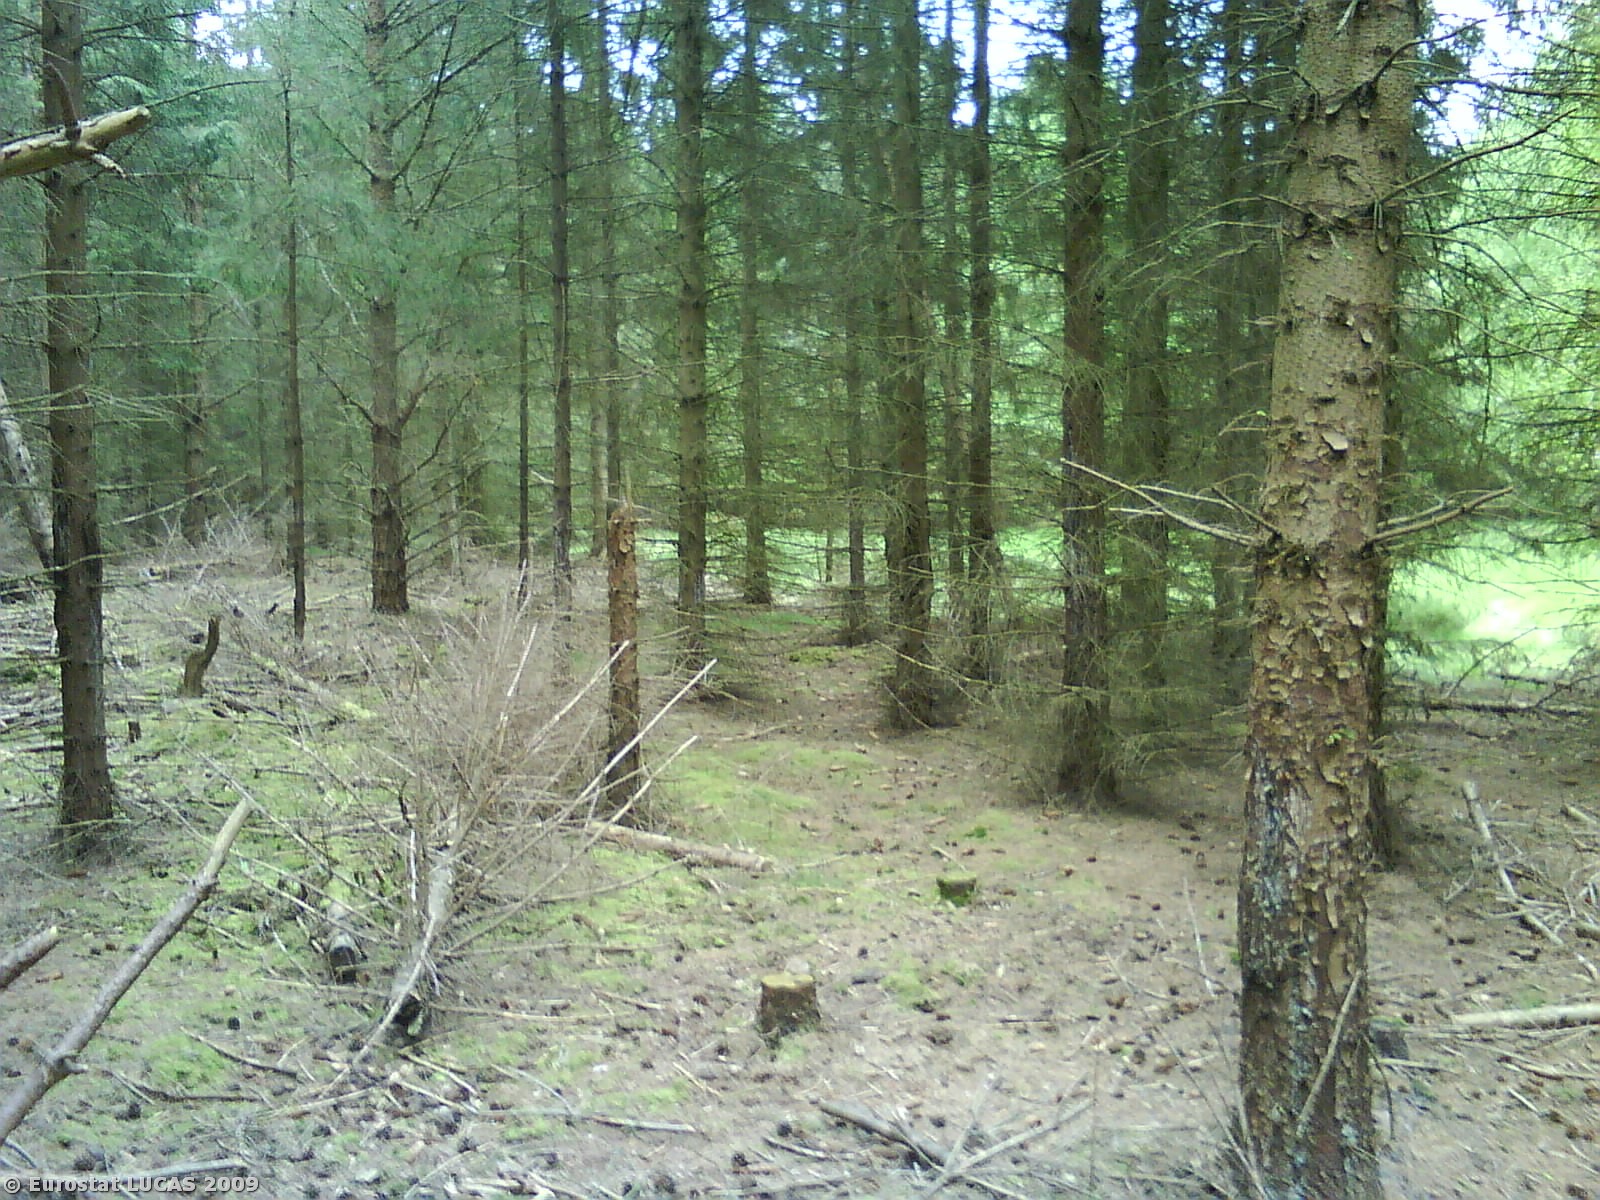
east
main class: Woodland
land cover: Coniferous woodland
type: hemiboreal forest and nemoral coniferous forest and mixed broadleaved-coniferous forest
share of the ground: 25 - 50 %
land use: Forestry
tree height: > 5 m
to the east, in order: Coniferous woodland; Mixed woodland; Grassland with sparse tree/shrub cover; Coniferous woodland; Grassland with sparse tree/shrub cover; Mixed woodland; Grassland with sparse tree/shrub cover
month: May
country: DK
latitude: 56.5091
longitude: 10.7627
